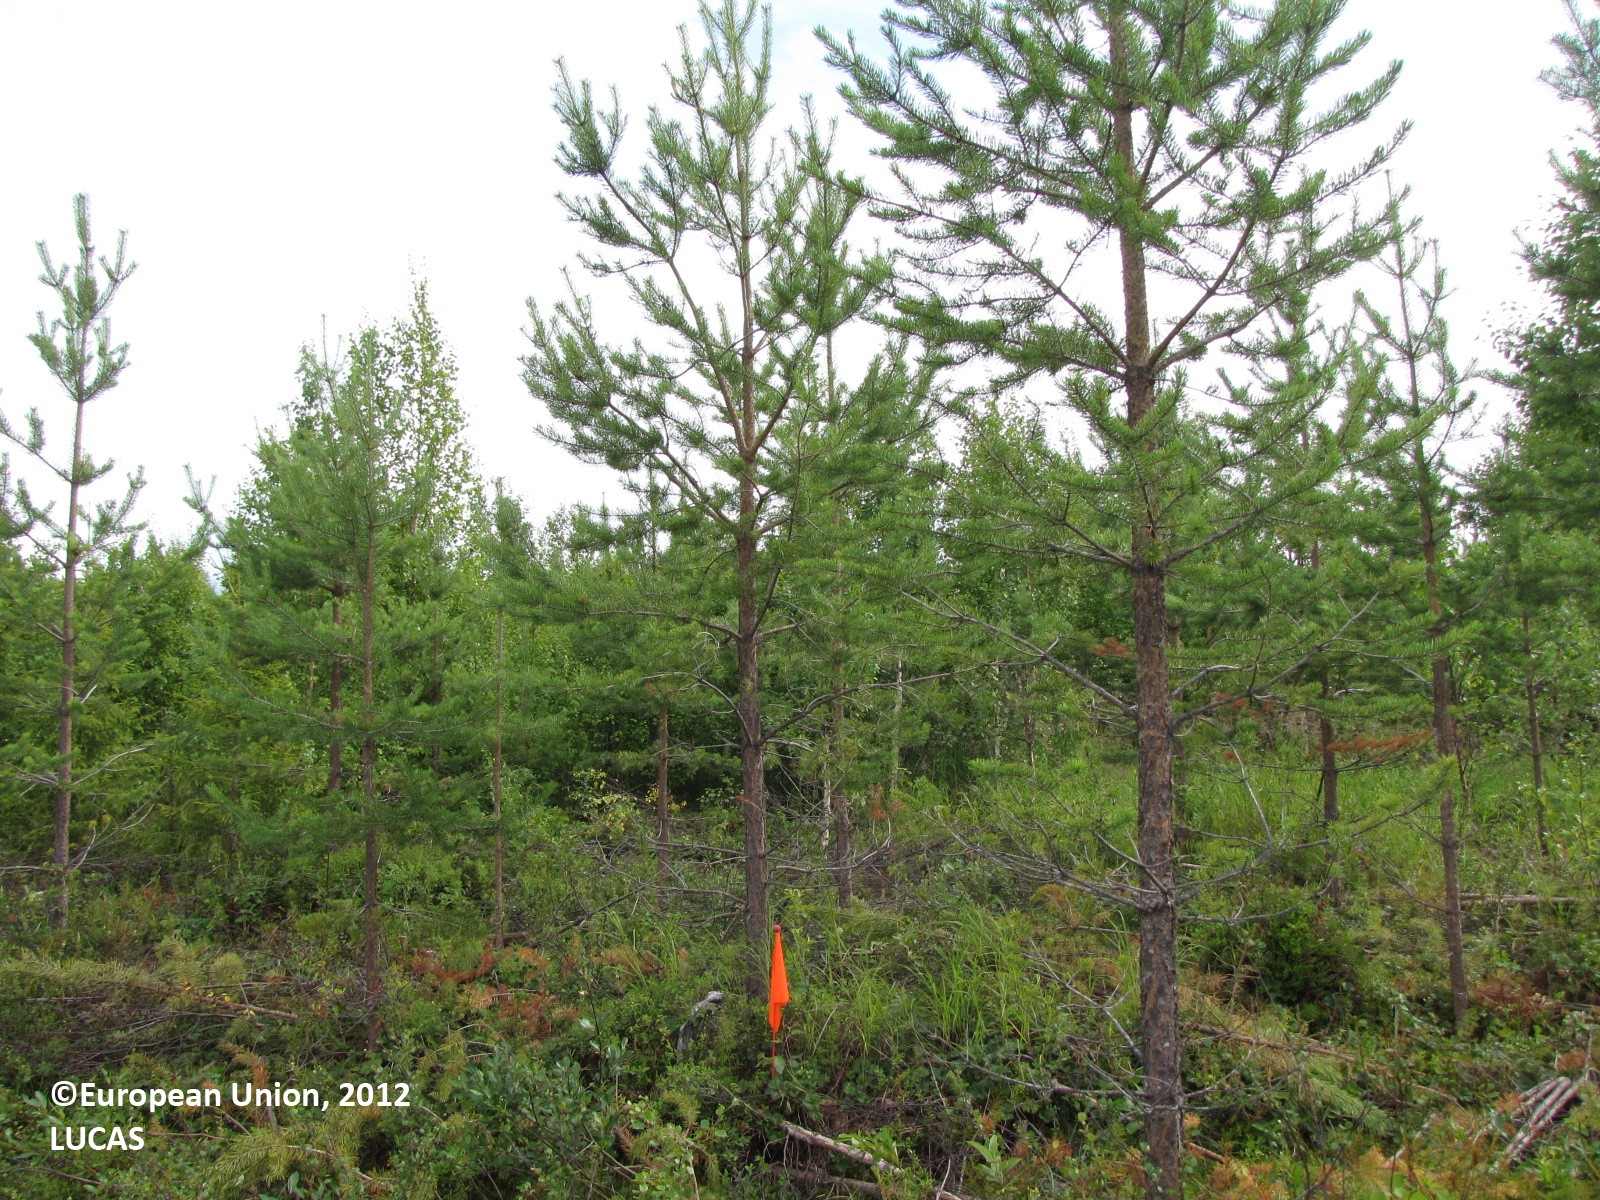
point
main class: Woodland
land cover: Pine dominated mixed woodland
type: boreal forest
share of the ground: 25 - 50 %
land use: Forestry
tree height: > 5 m
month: August
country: FI
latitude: 66.7328
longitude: 24.5385
